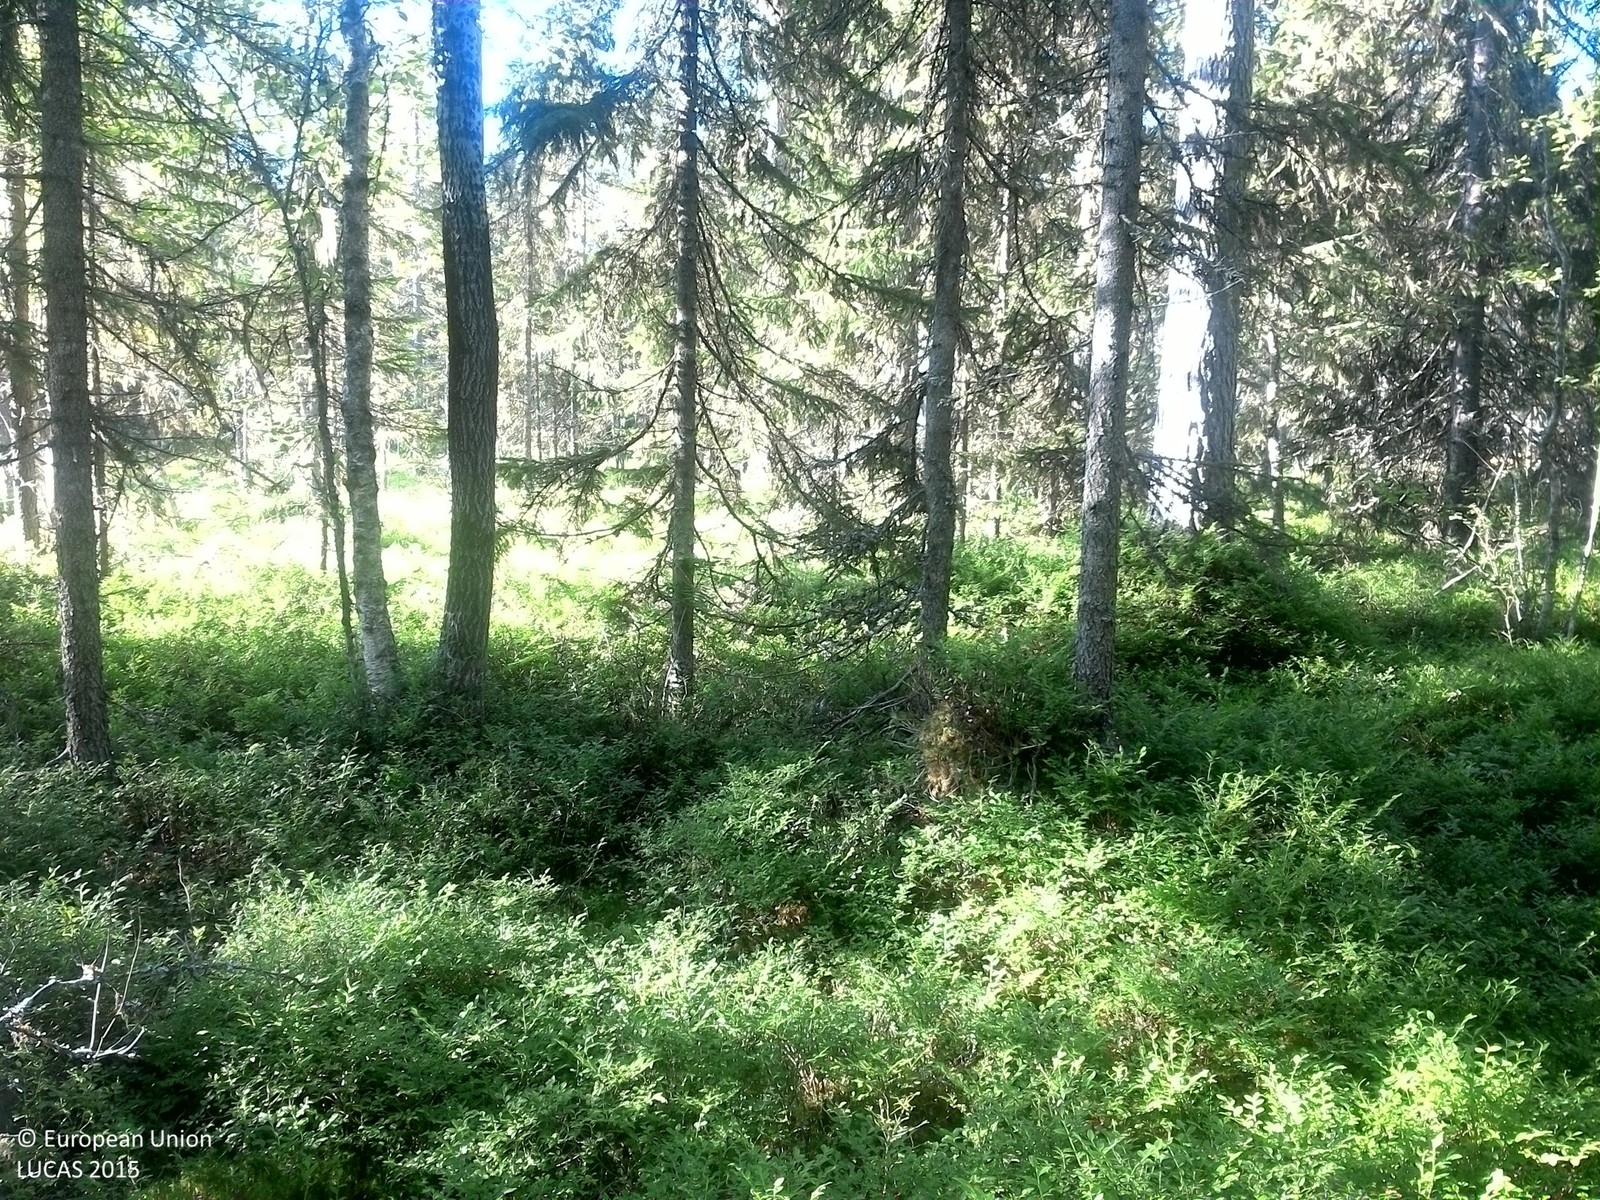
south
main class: Woodland
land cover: Spruce dominated coniferous woodland
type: boreal forest
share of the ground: 25 - 50 %
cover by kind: coniferous forest trees 40 %, shrubs 40 %, herbaceous plants 15 %, broadleaved forest trees 5 %
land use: Forestry
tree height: > 5 m
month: August
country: SE
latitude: 63.7697
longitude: 16.6440
